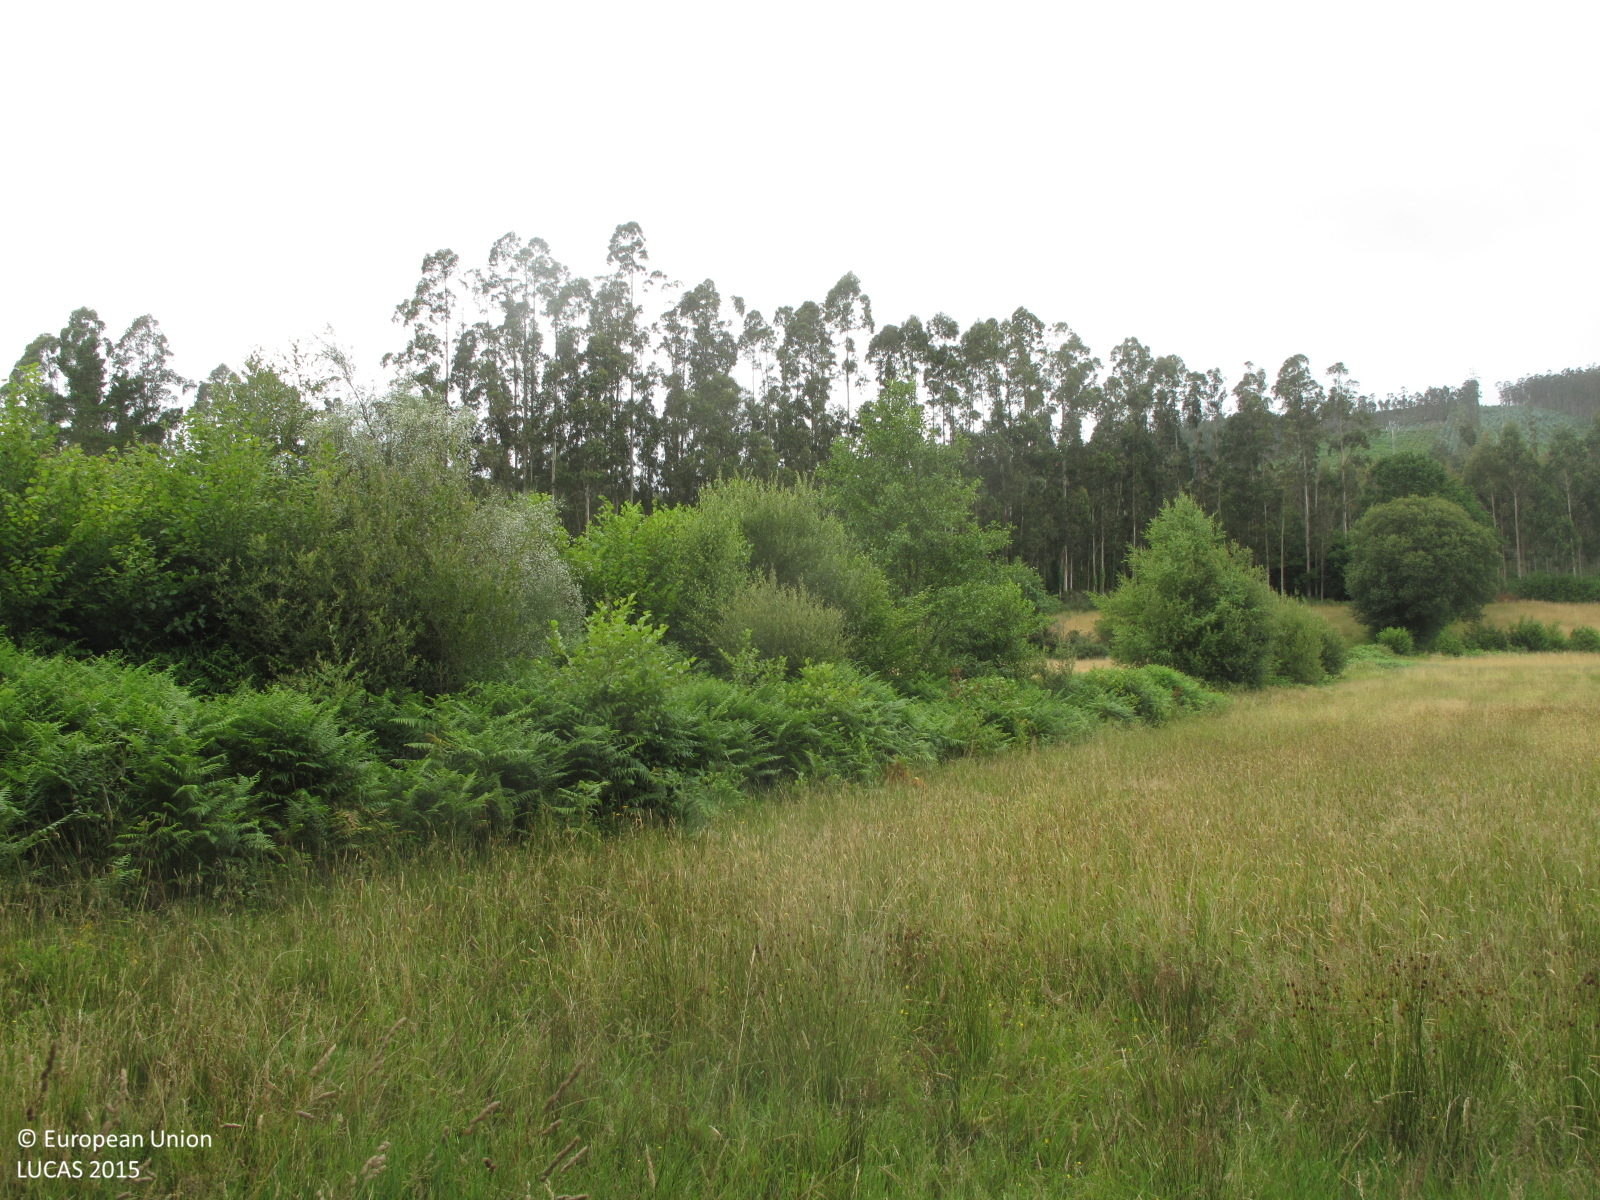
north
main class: Grassland
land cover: Grassland without tree/shrub cover
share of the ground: > 75 %
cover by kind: herbaceous plants 100 %
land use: Agriculture (excluding fallow land and kitchen gardens)
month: July
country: ES
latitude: 43.5828
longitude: -8.0434
